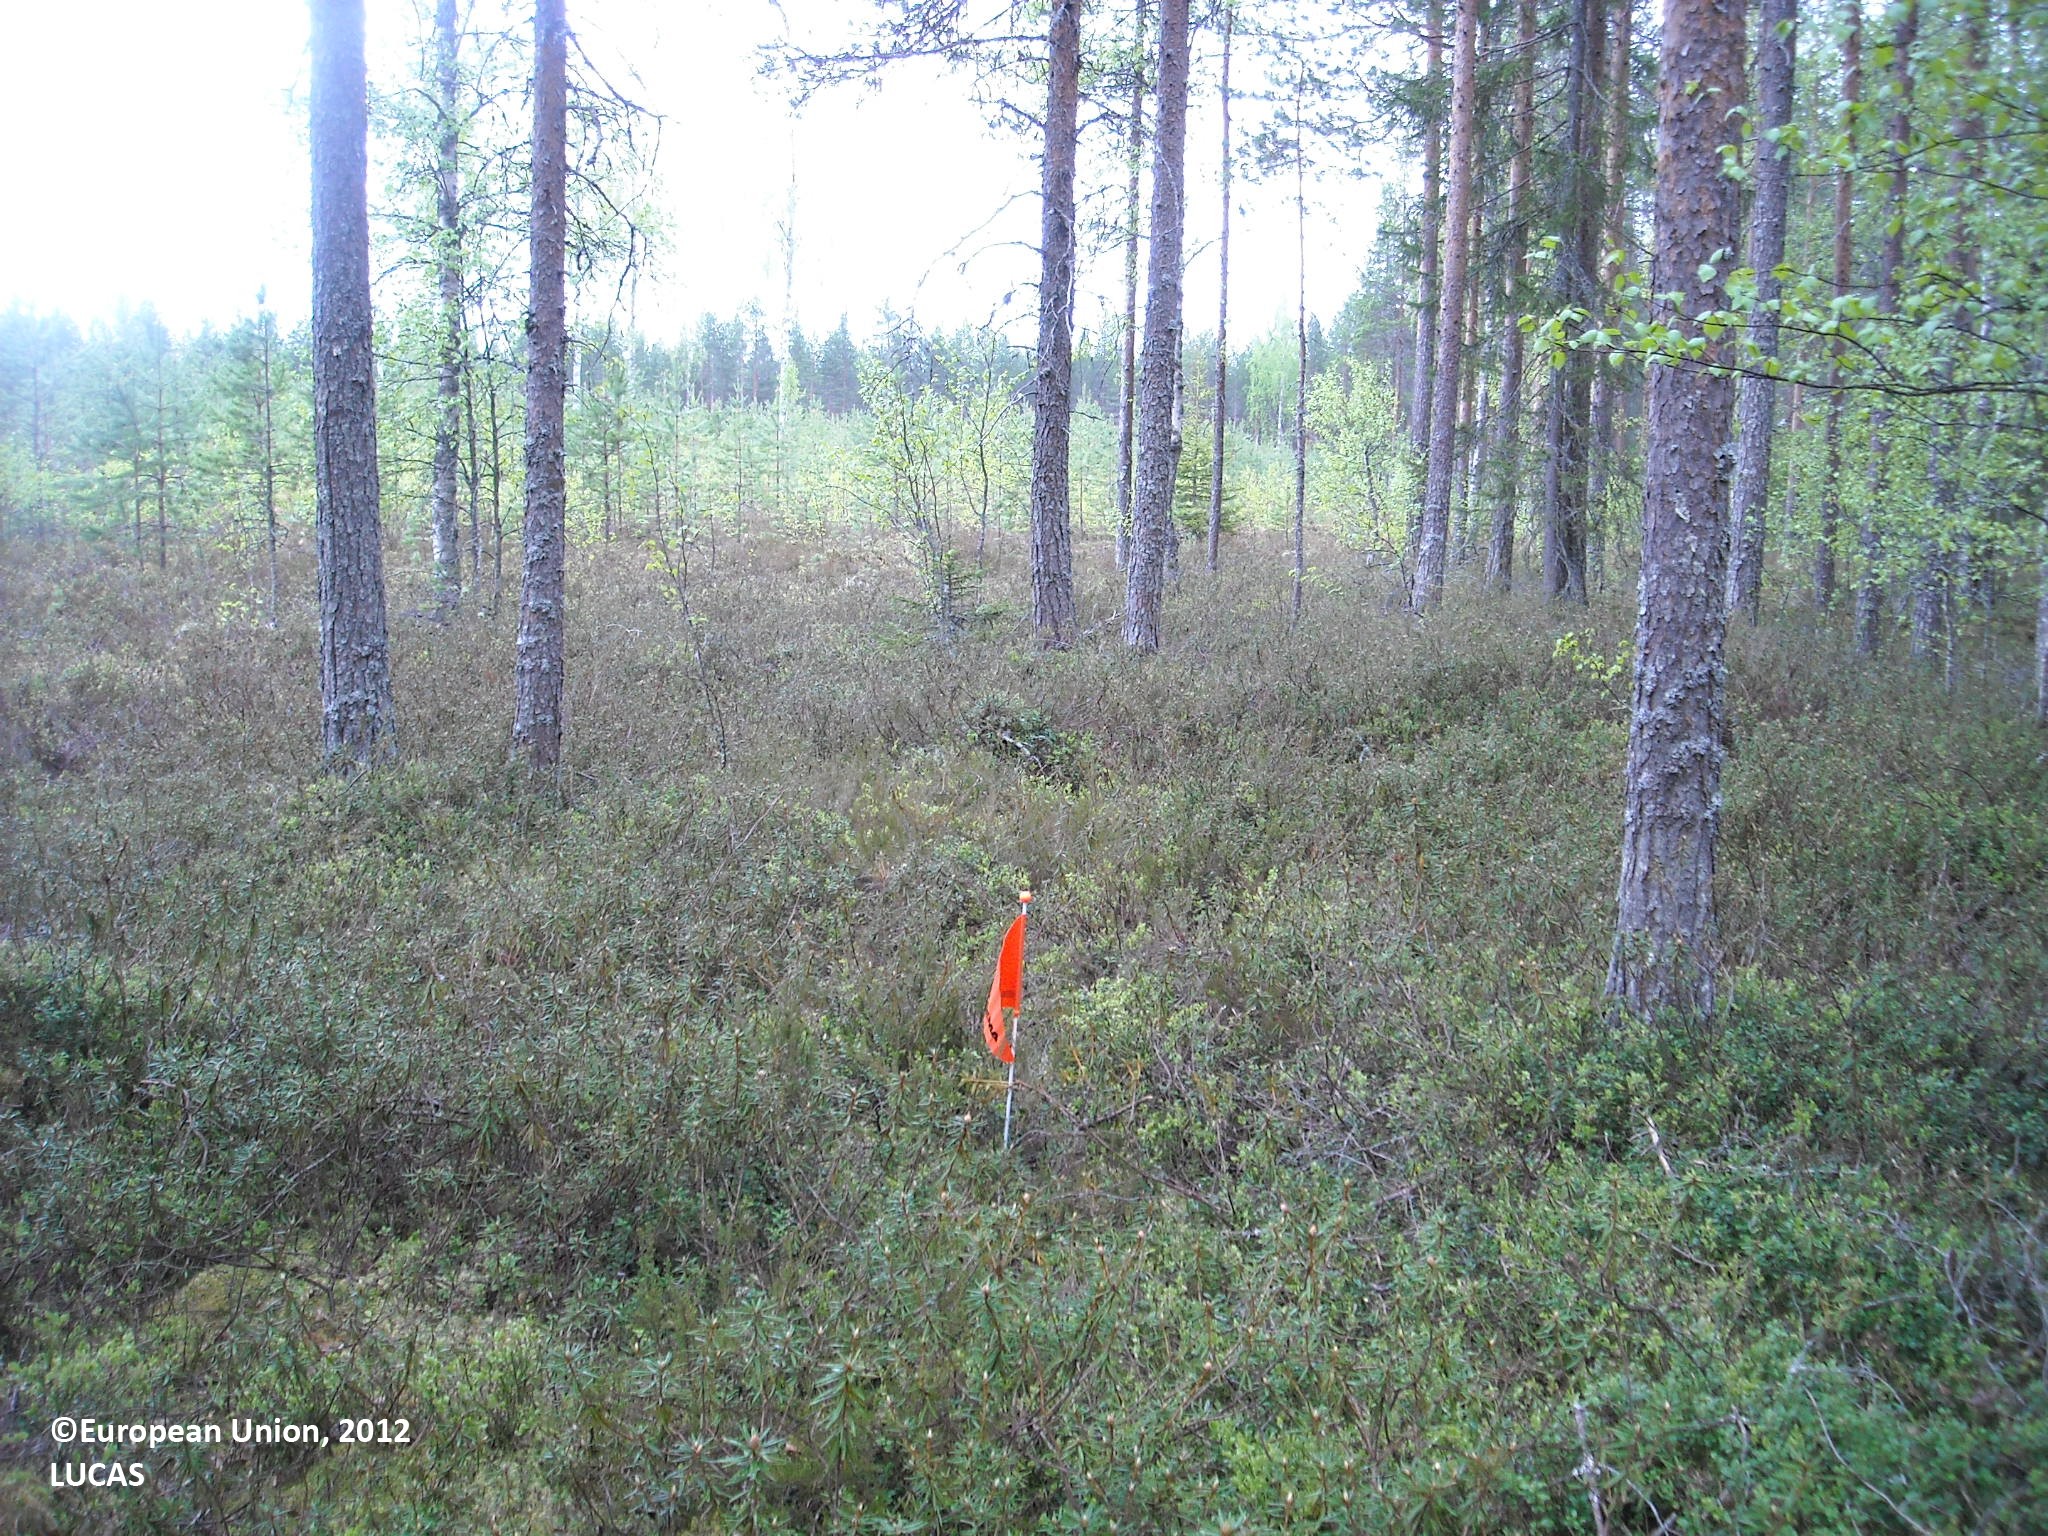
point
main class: Woodland
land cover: Pine dominated mixed woodland
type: boreal forest
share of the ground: > 75 %
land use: Forestry
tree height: > 5 m
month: June
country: FI
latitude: 64.6521
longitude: 27.2370
